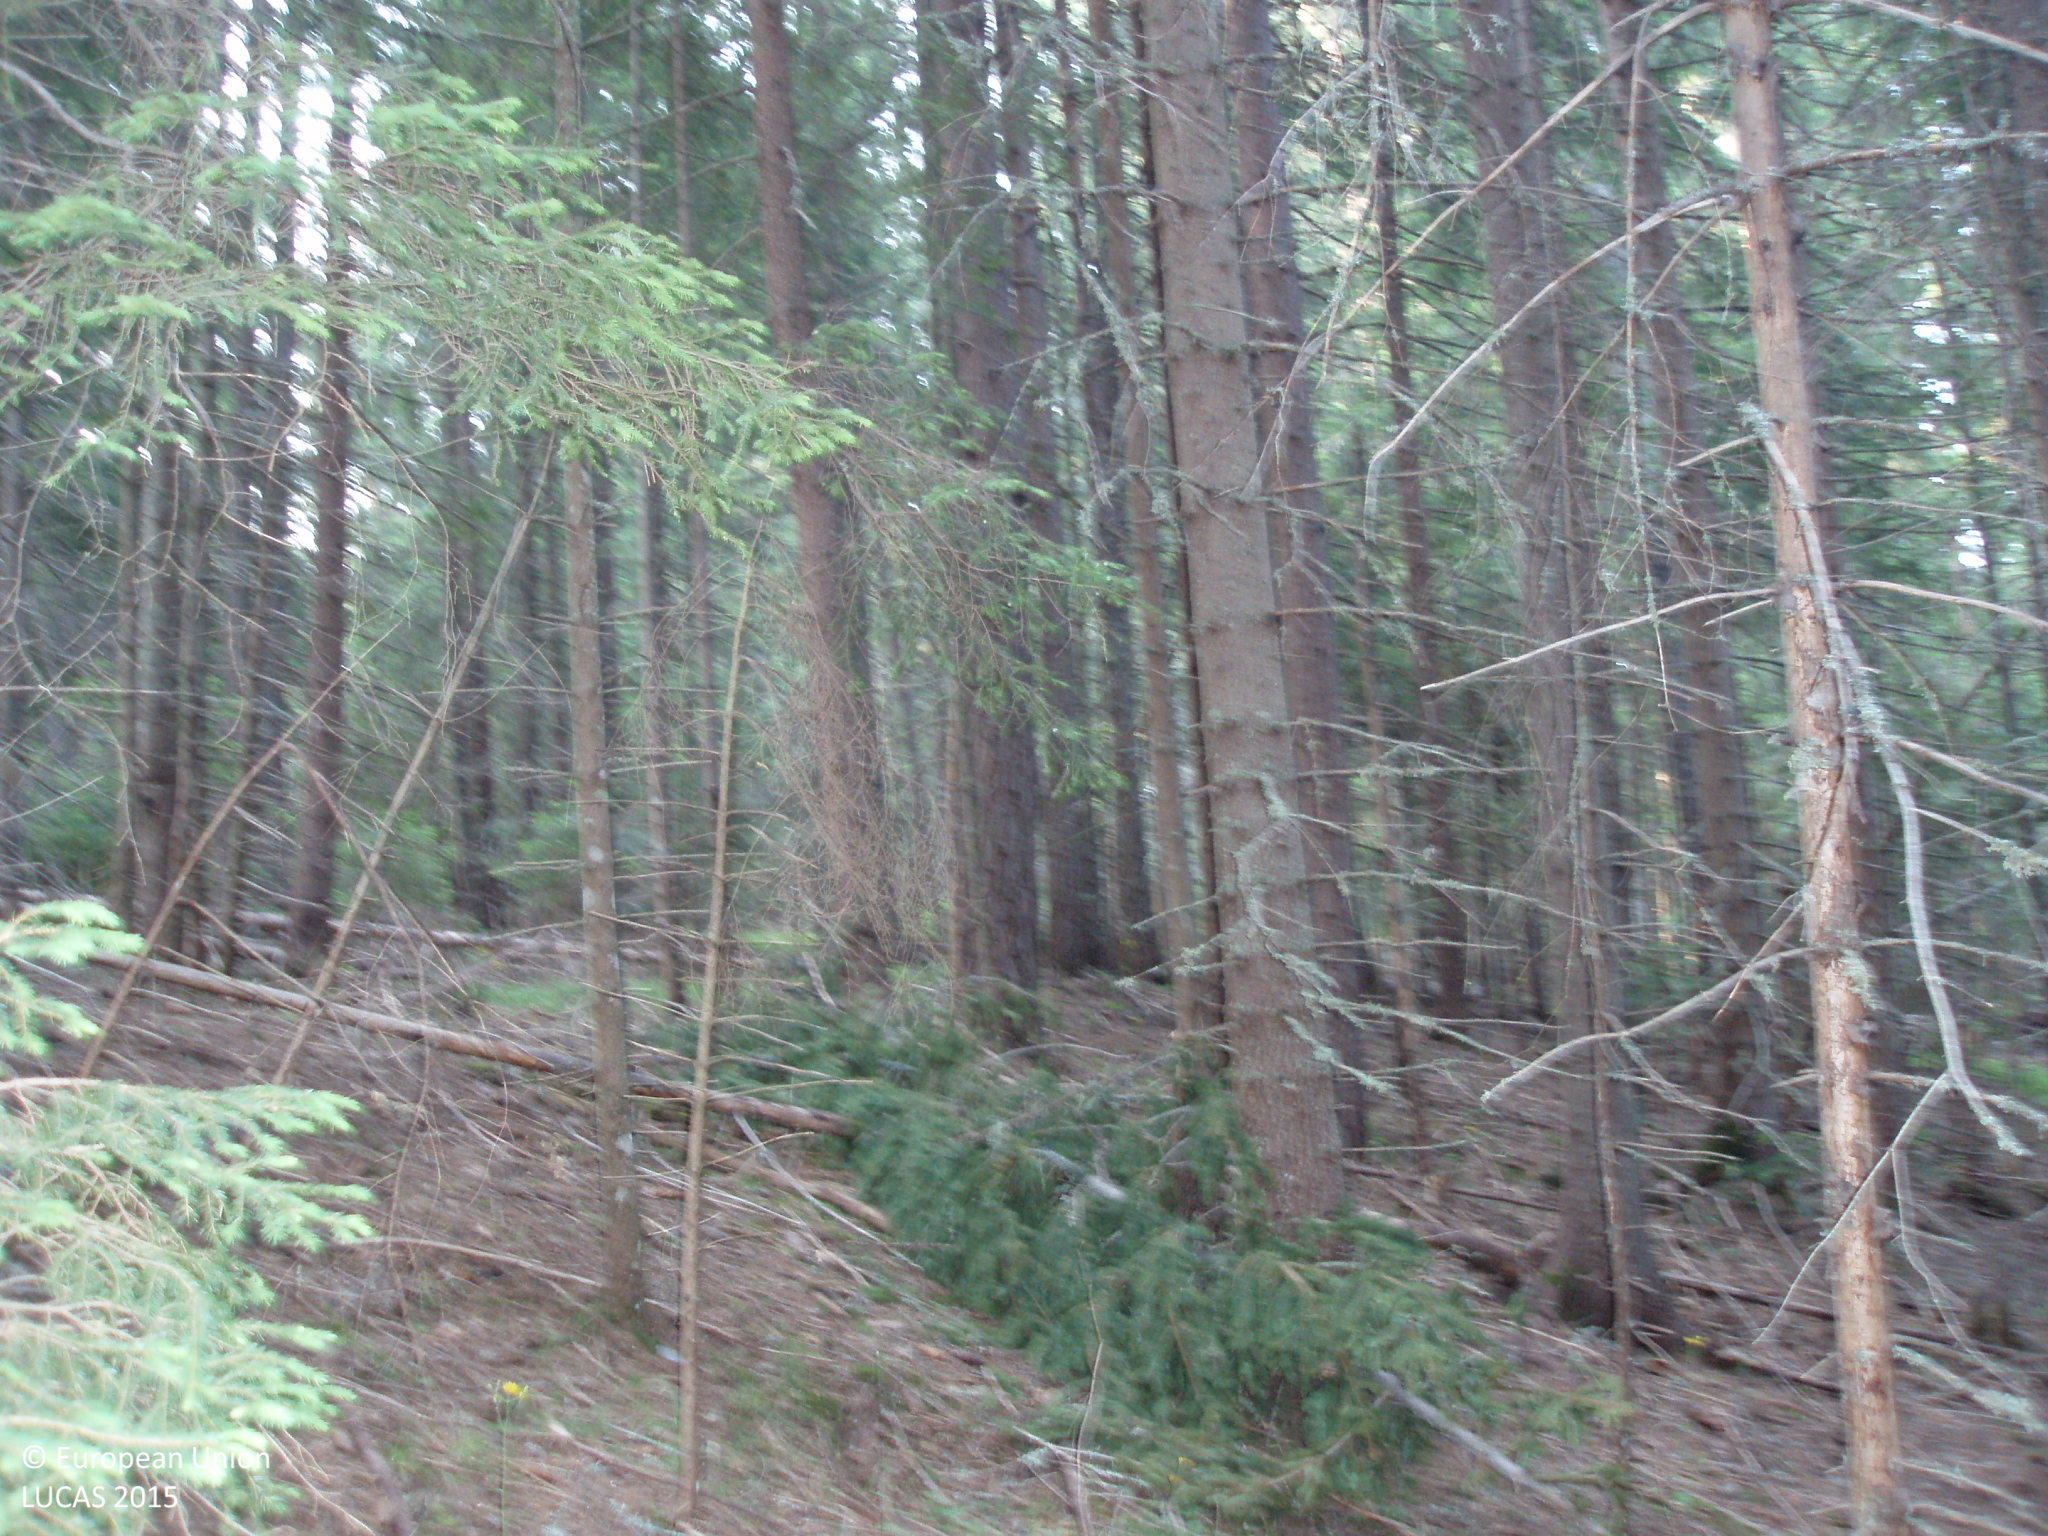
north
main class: Woodland
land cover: Spruce dominated coniferous woodland
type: hemiboreal forest and nemoral coniferous forest and mixed broadleaved-coniferous forest
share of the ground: > 75 %
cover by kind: coniferous forest trees 100 %
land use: Forestry
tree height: > 5 m
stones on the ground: 25 - 50 %
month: July
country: BG
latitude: 42.1010
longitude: 23.7098
